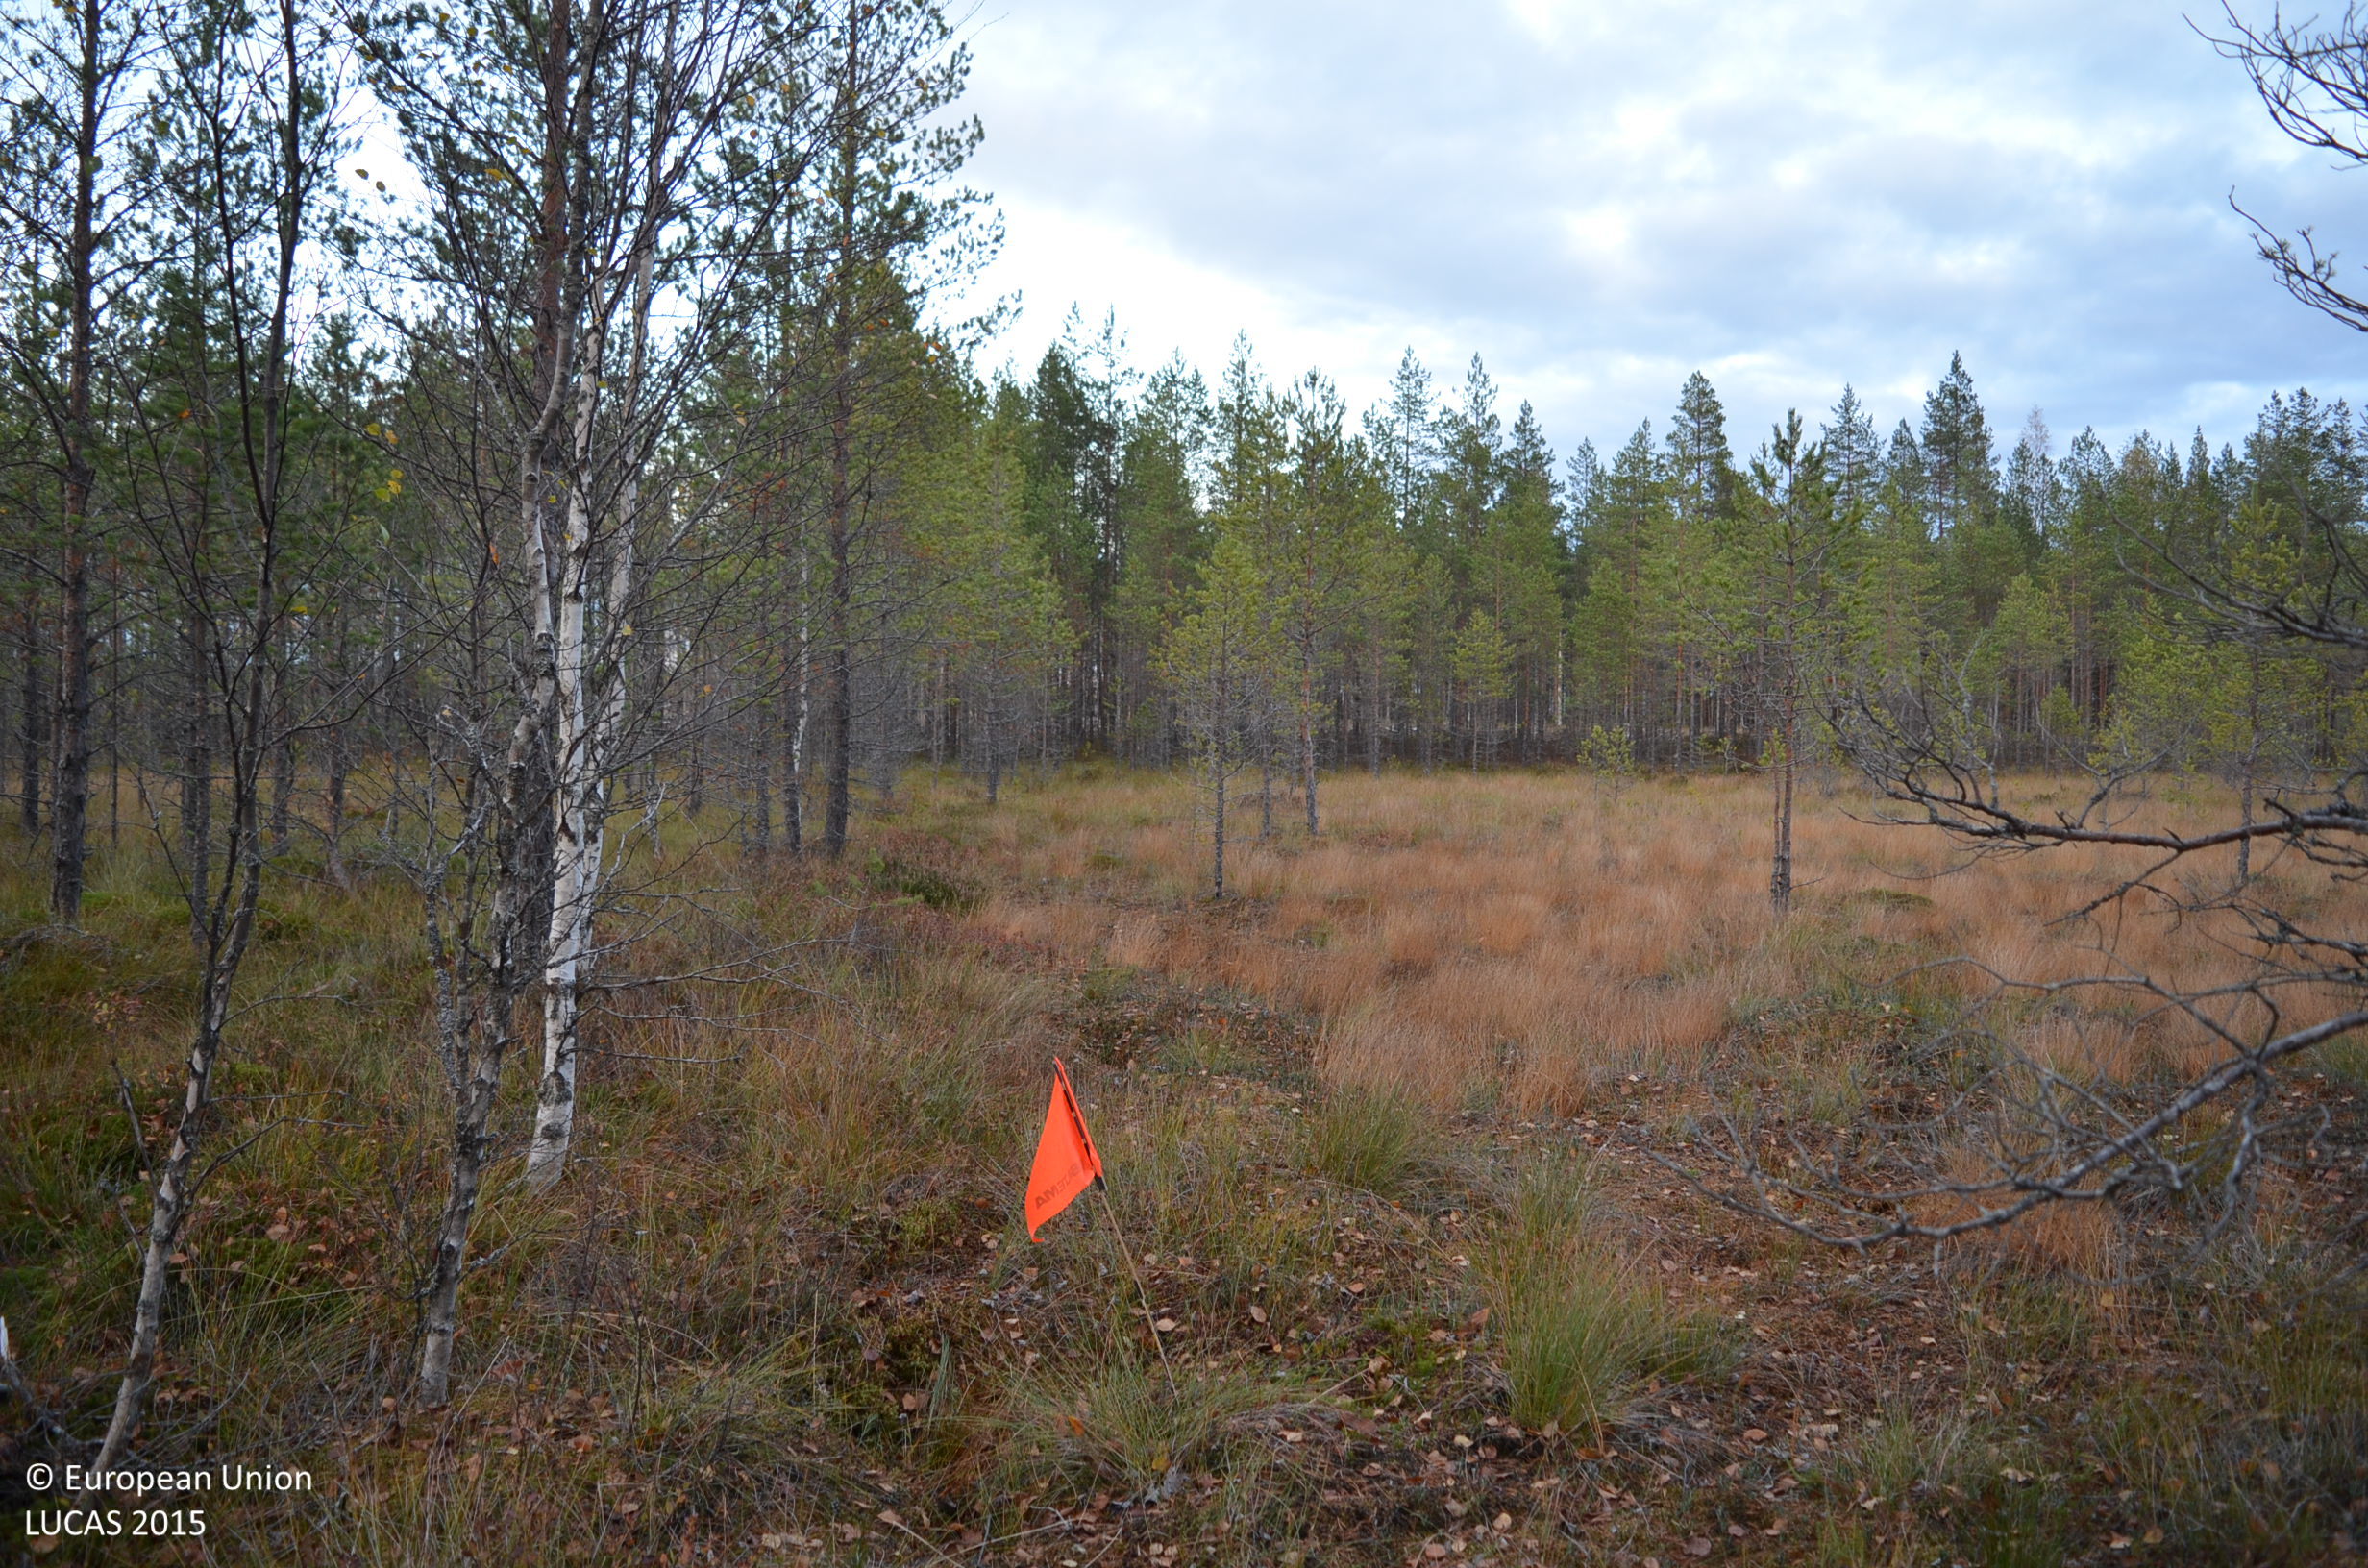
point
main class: Woodland
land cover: Pine dominated mixed woodland
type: mire and swamp forests
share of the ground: 25 - 50 %
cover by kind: coniferous forest trees 30 %, herbaceous plants 20 %, lichens and mosses 20 %, broadleaved forest trees 15 %, shrubs 15 %
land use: Semi-natural and natural areas not in use
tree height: < 5 m
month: October
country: FI
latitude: 62.3319
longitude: 23.4887
